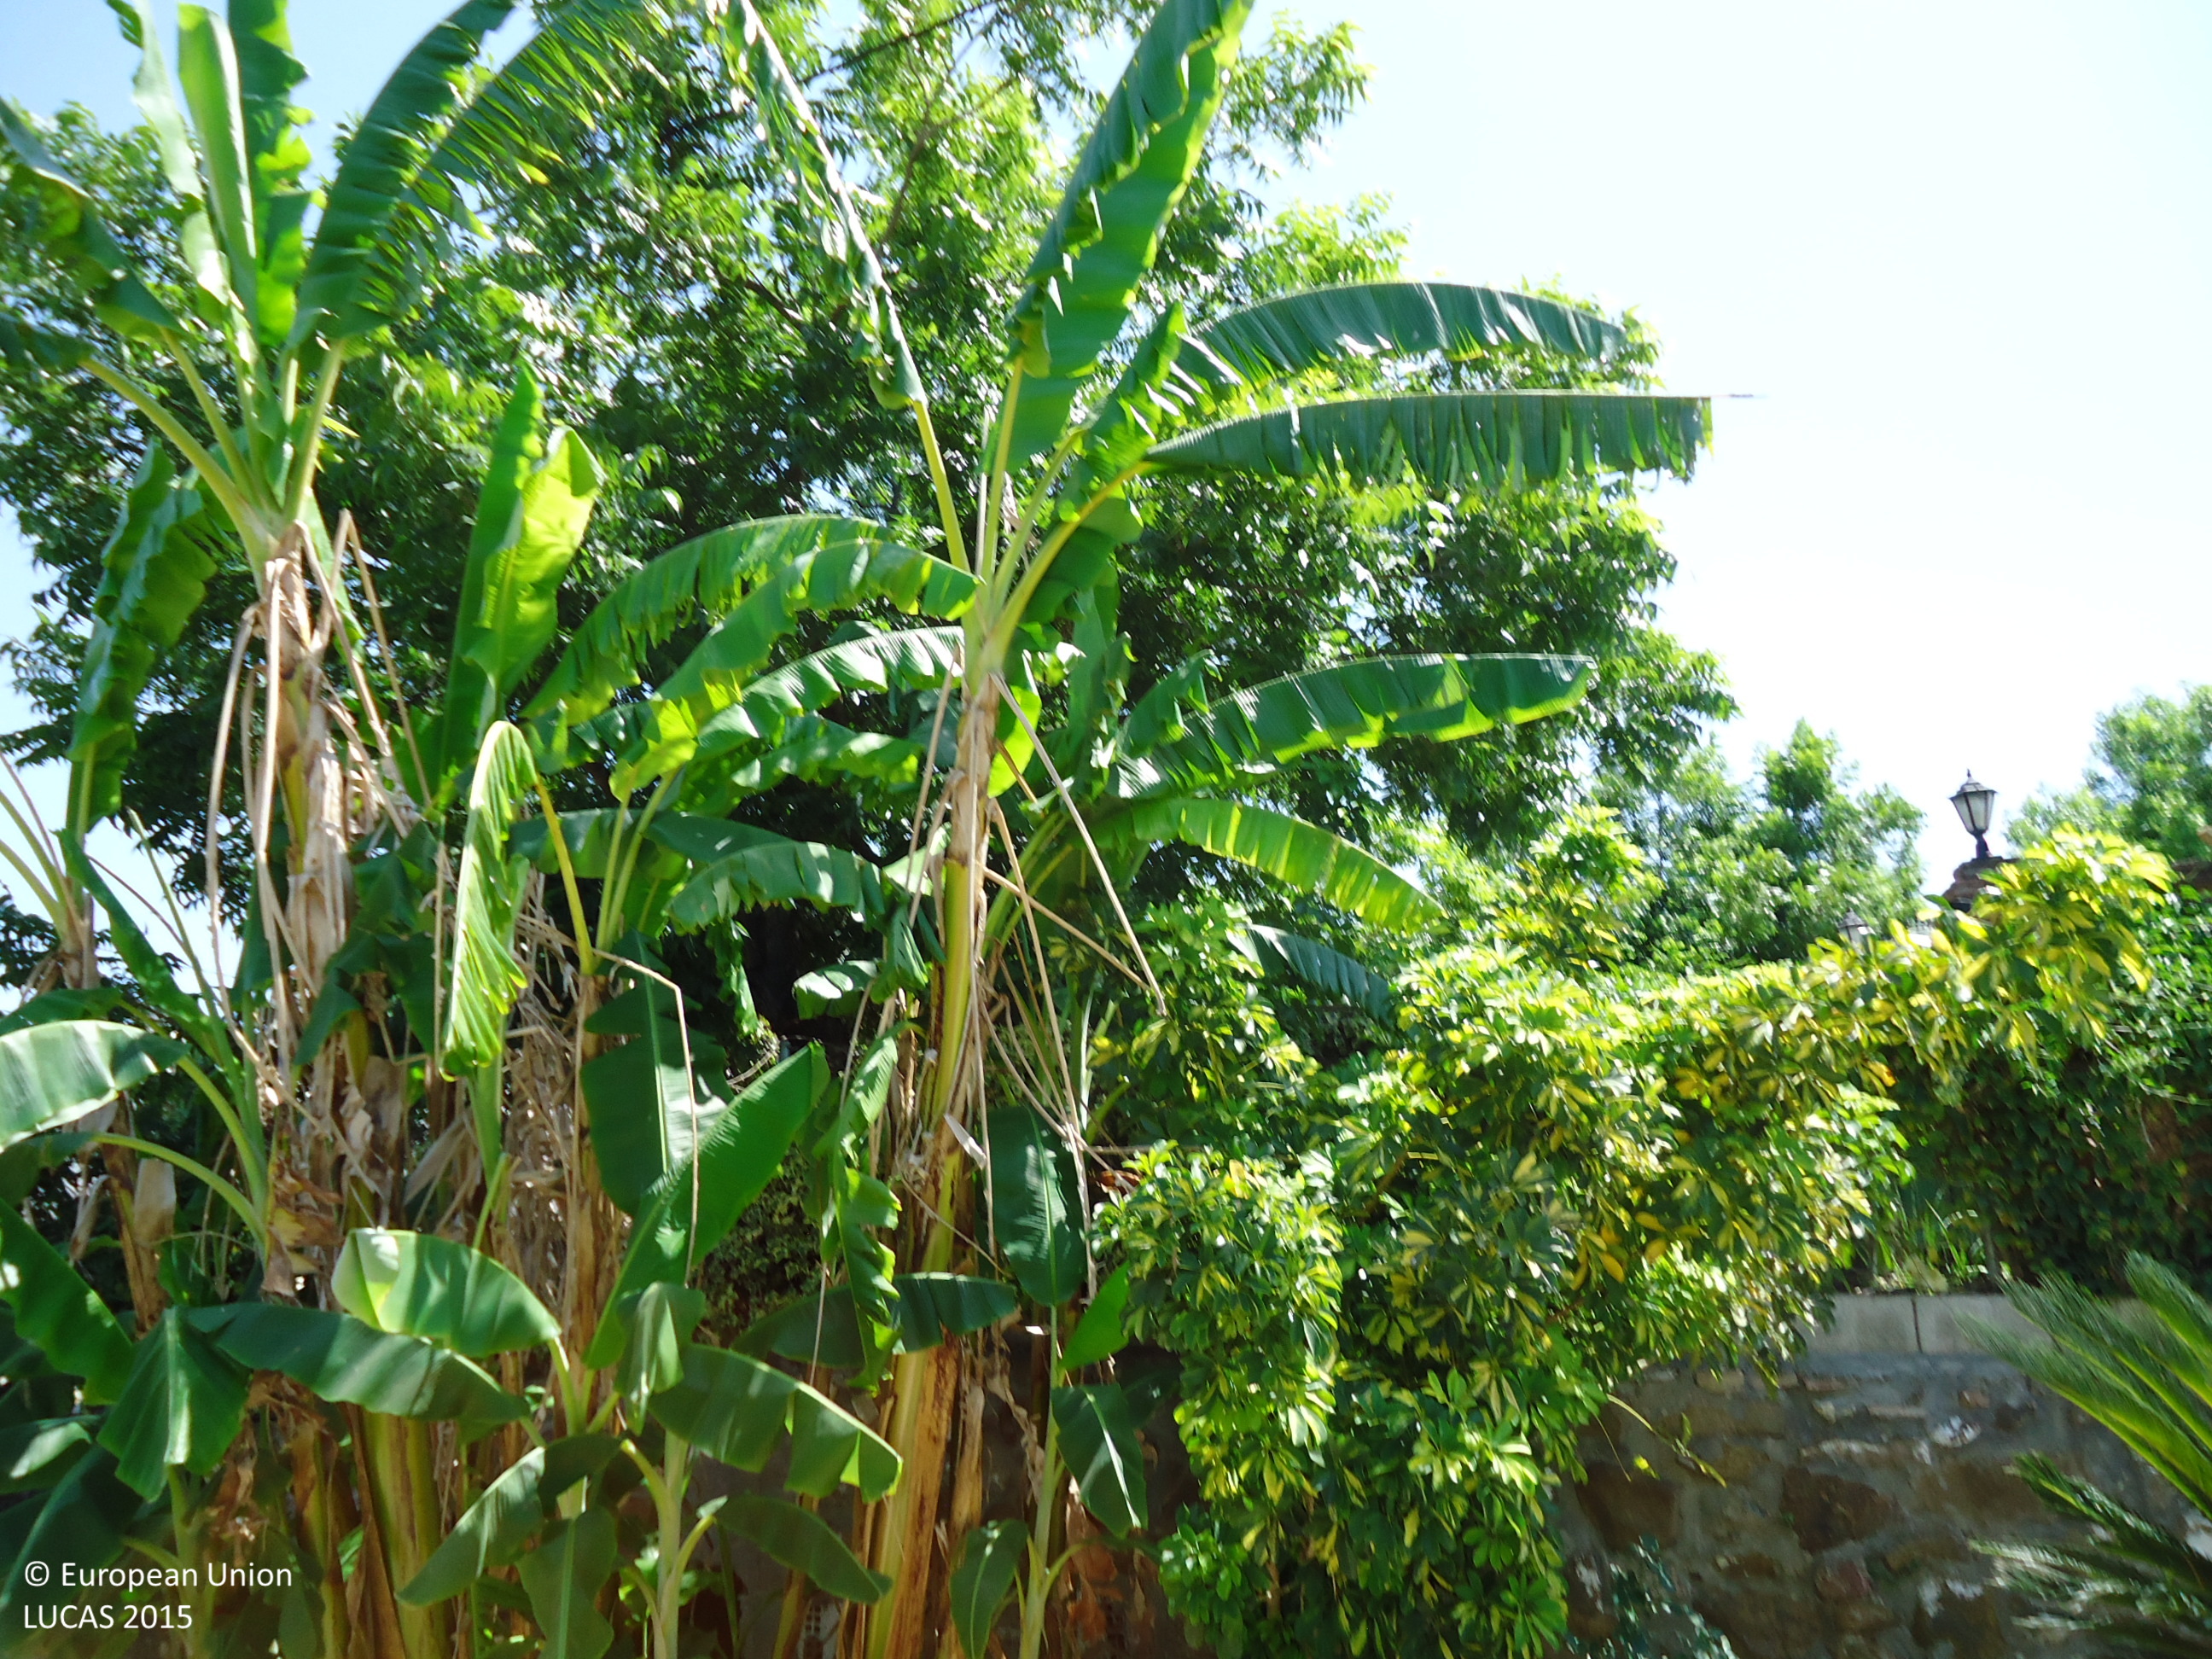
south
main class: Cropland
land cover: Oranges
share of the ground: 25 - 50 %
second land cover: Spontaneously vegetated surfaces
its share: > 75 %
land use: Agriculture (excluding fallow land and kitchen gardens)
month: June
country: ES
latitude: 36.6998
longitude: -4.7571
